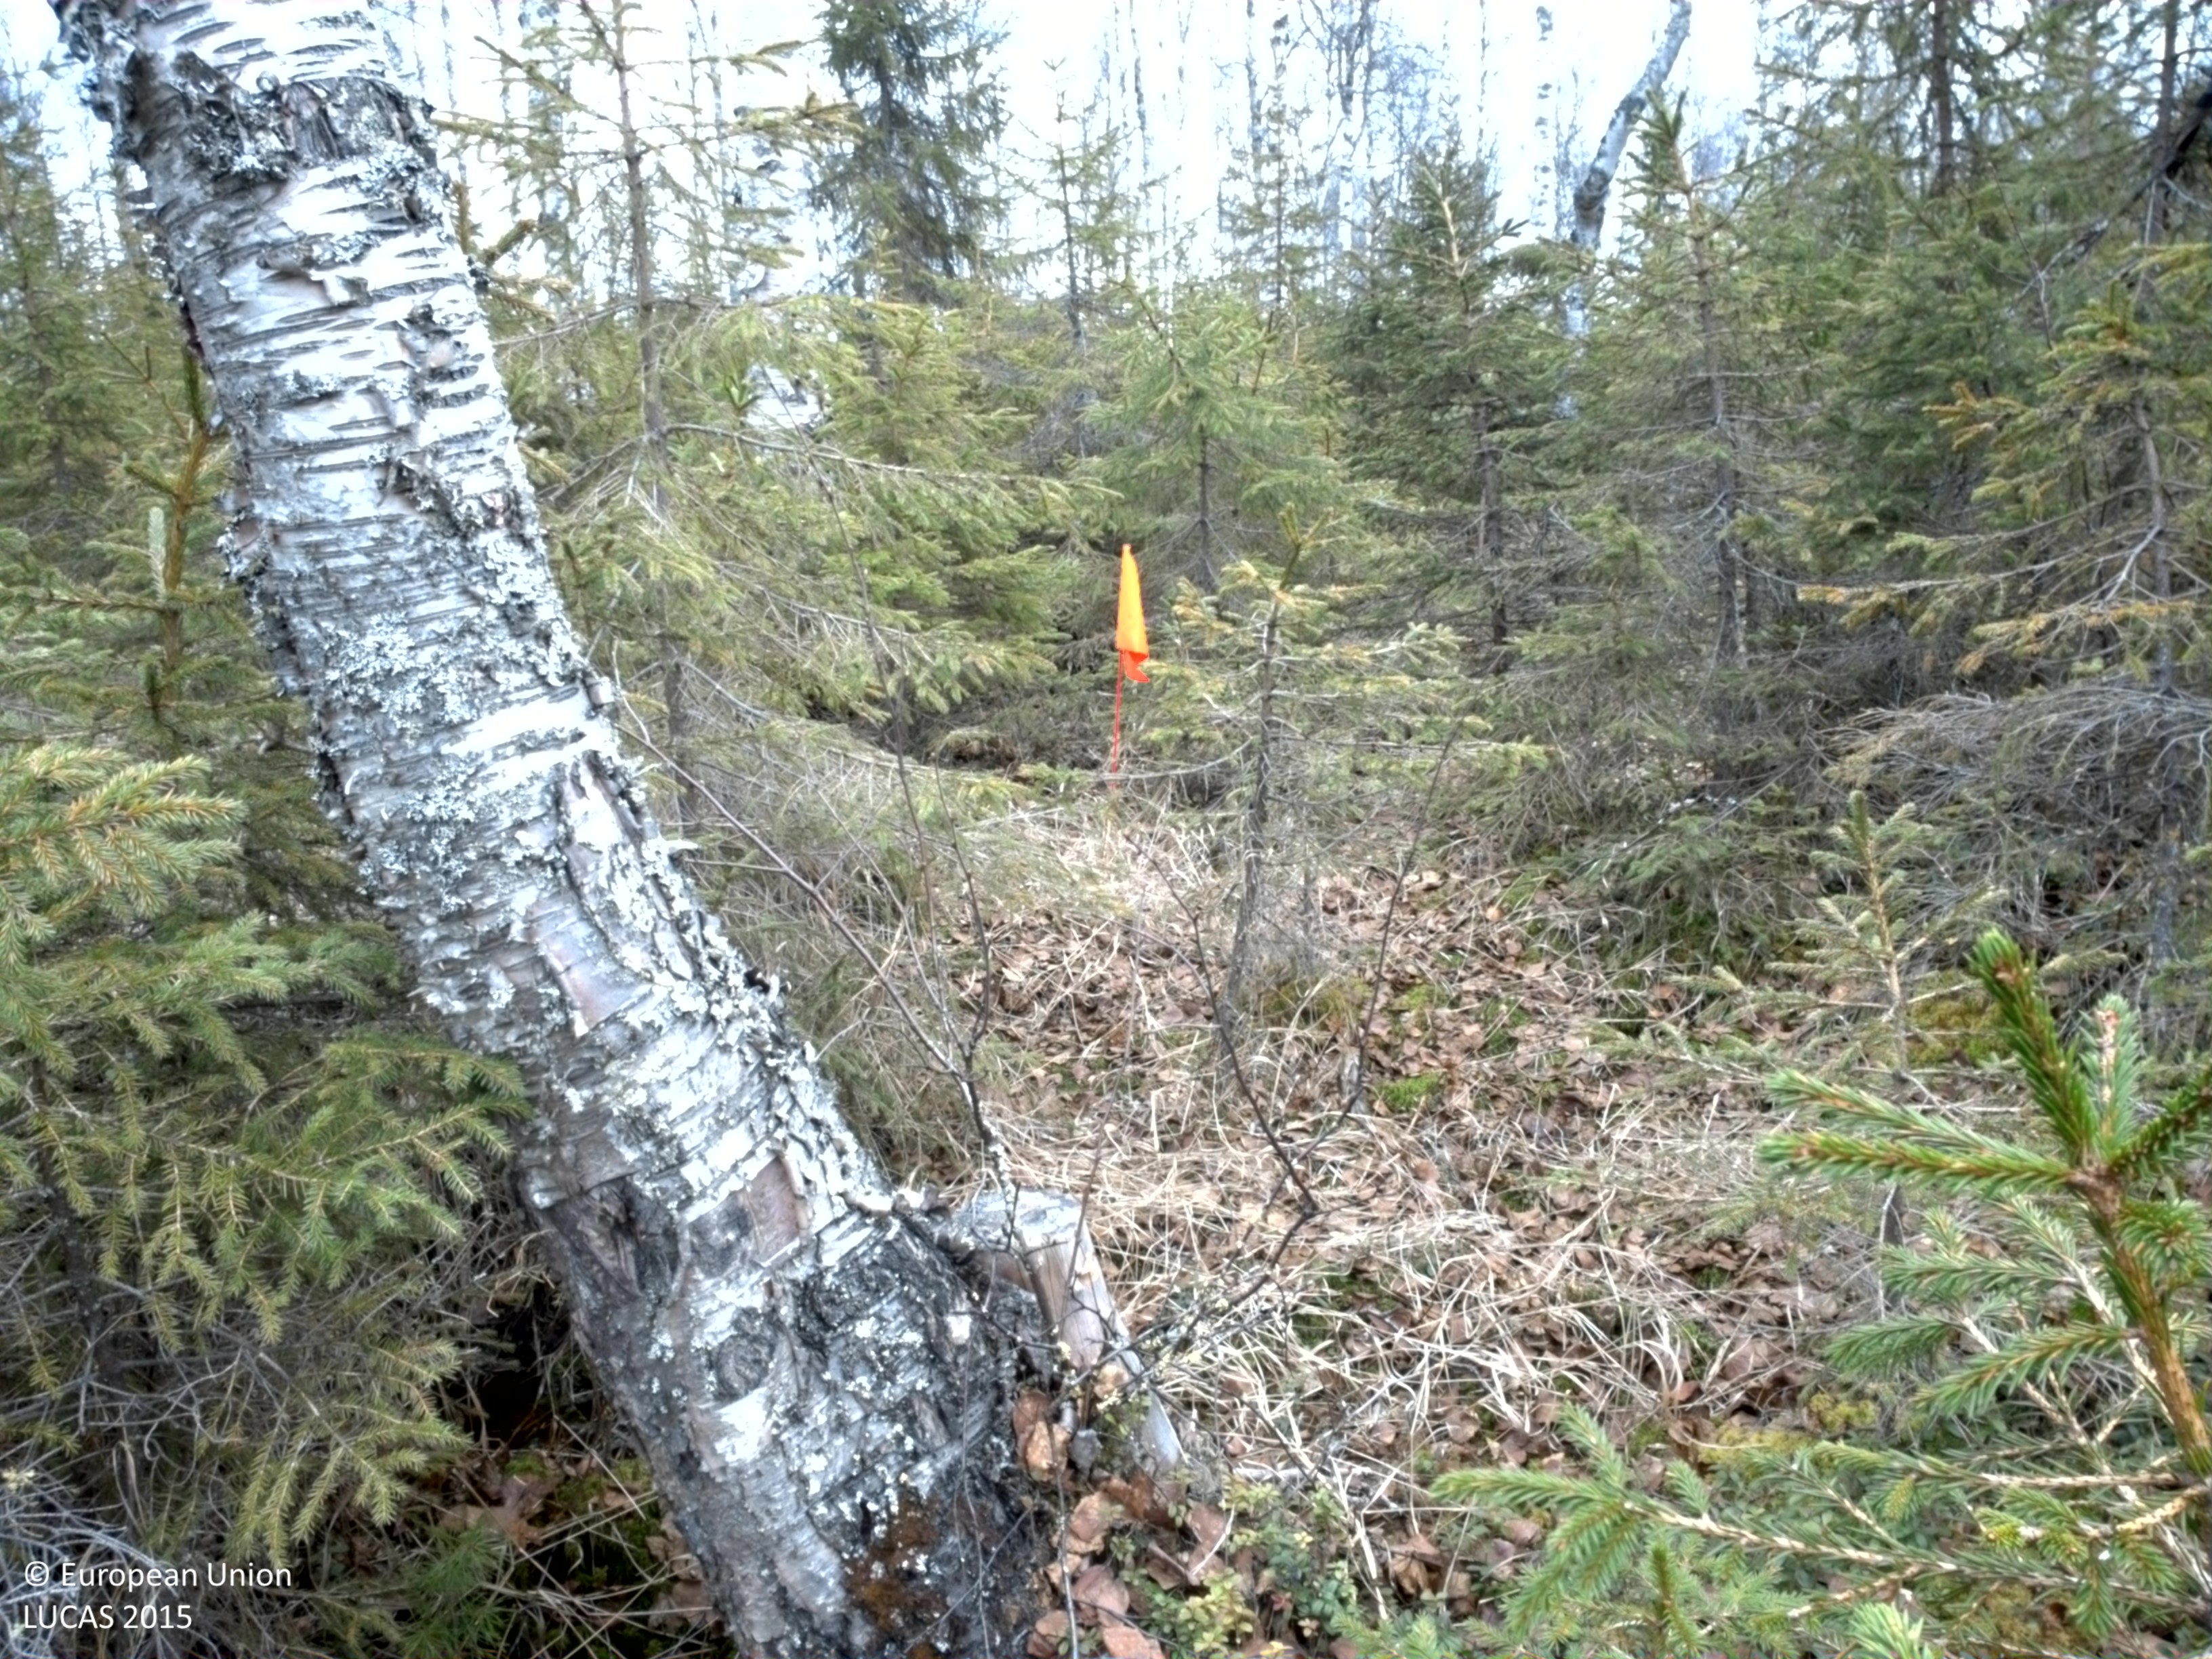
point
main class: Woodland
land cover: Spruce dominated mixed woodland
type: boreal forest
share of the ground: > 75 %
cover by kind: coniferous forest trees 60 %, broadleaved forest trees 20 %, herbaceous plants 10 %, shrubs 5 %, lichens and mosses 5 %
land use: Forestry
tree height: > 5 m
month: May
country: SE
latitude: 66.1309
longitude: 23.7909
